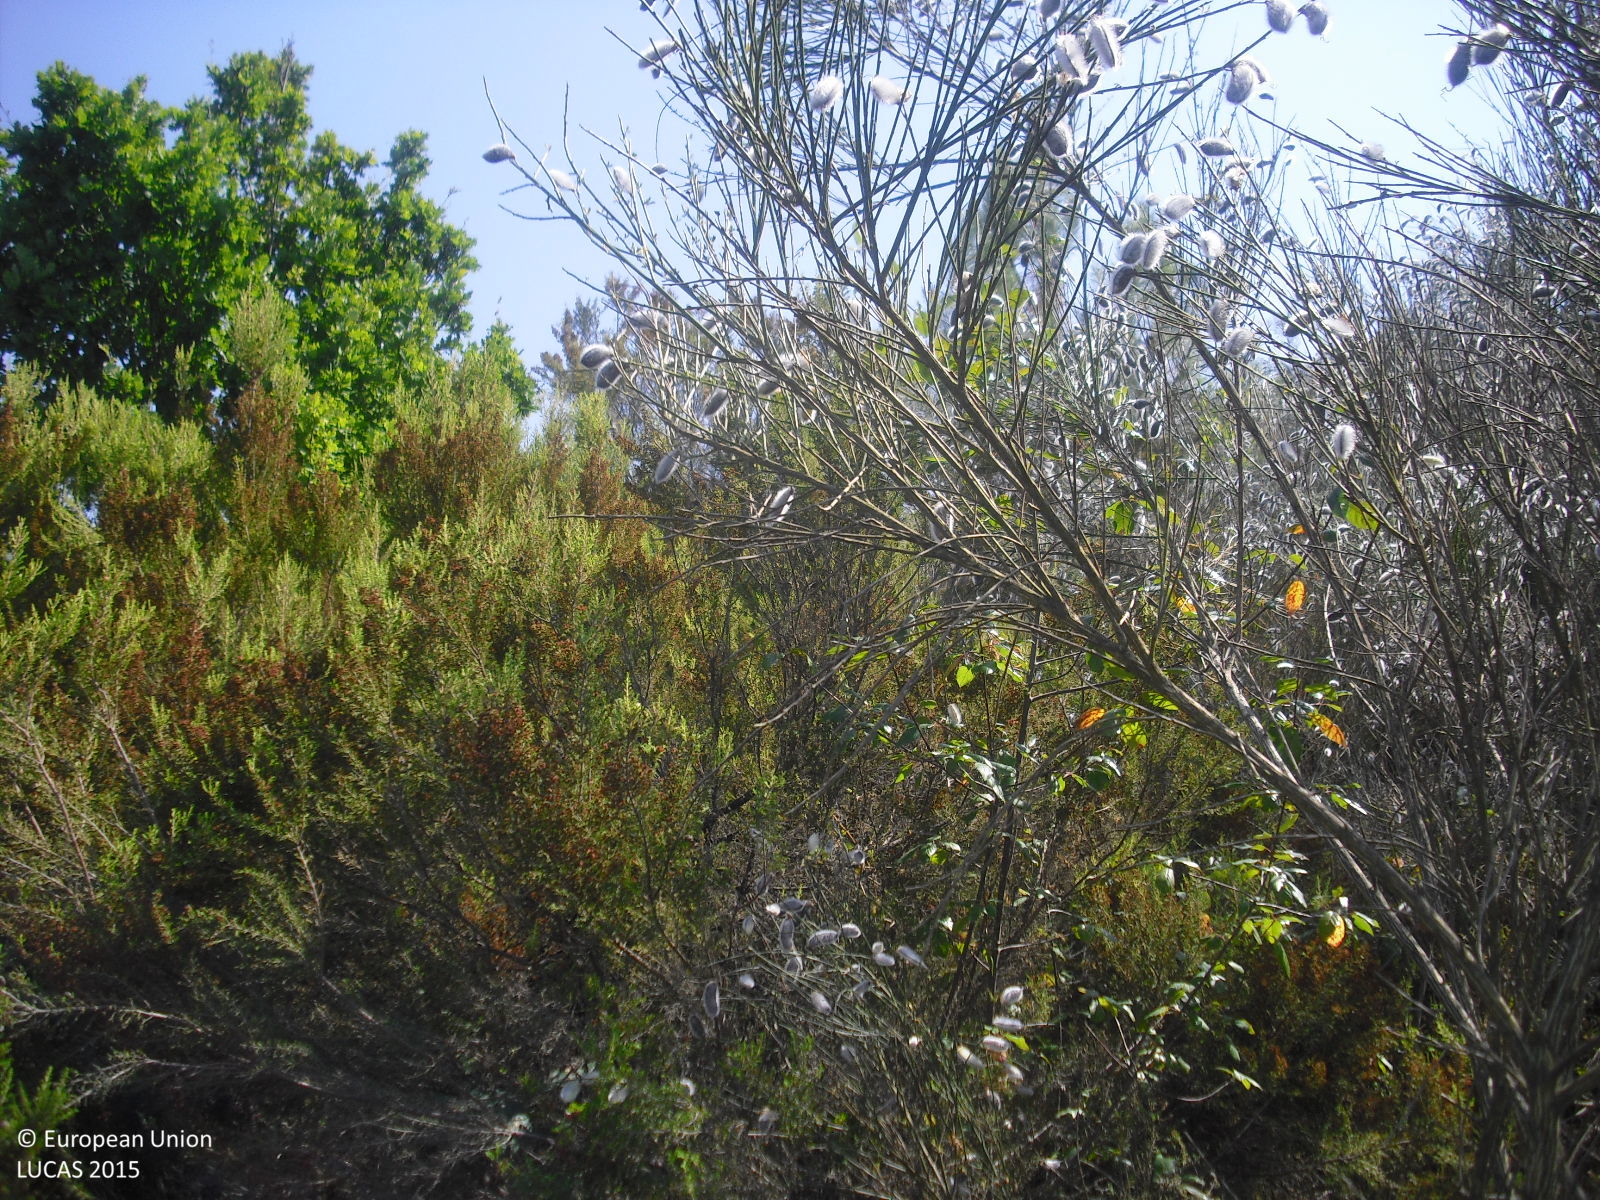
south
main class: Shrubland
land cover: Shrubland with sparse tree cover
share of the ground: > 75 %
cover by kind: shrubs 95 %, broadleaved forest trees 5 %
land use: Forestry
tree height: < 5 m
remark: Clear cut
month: July
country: ES
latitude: 42.4537
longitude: -7.4430
